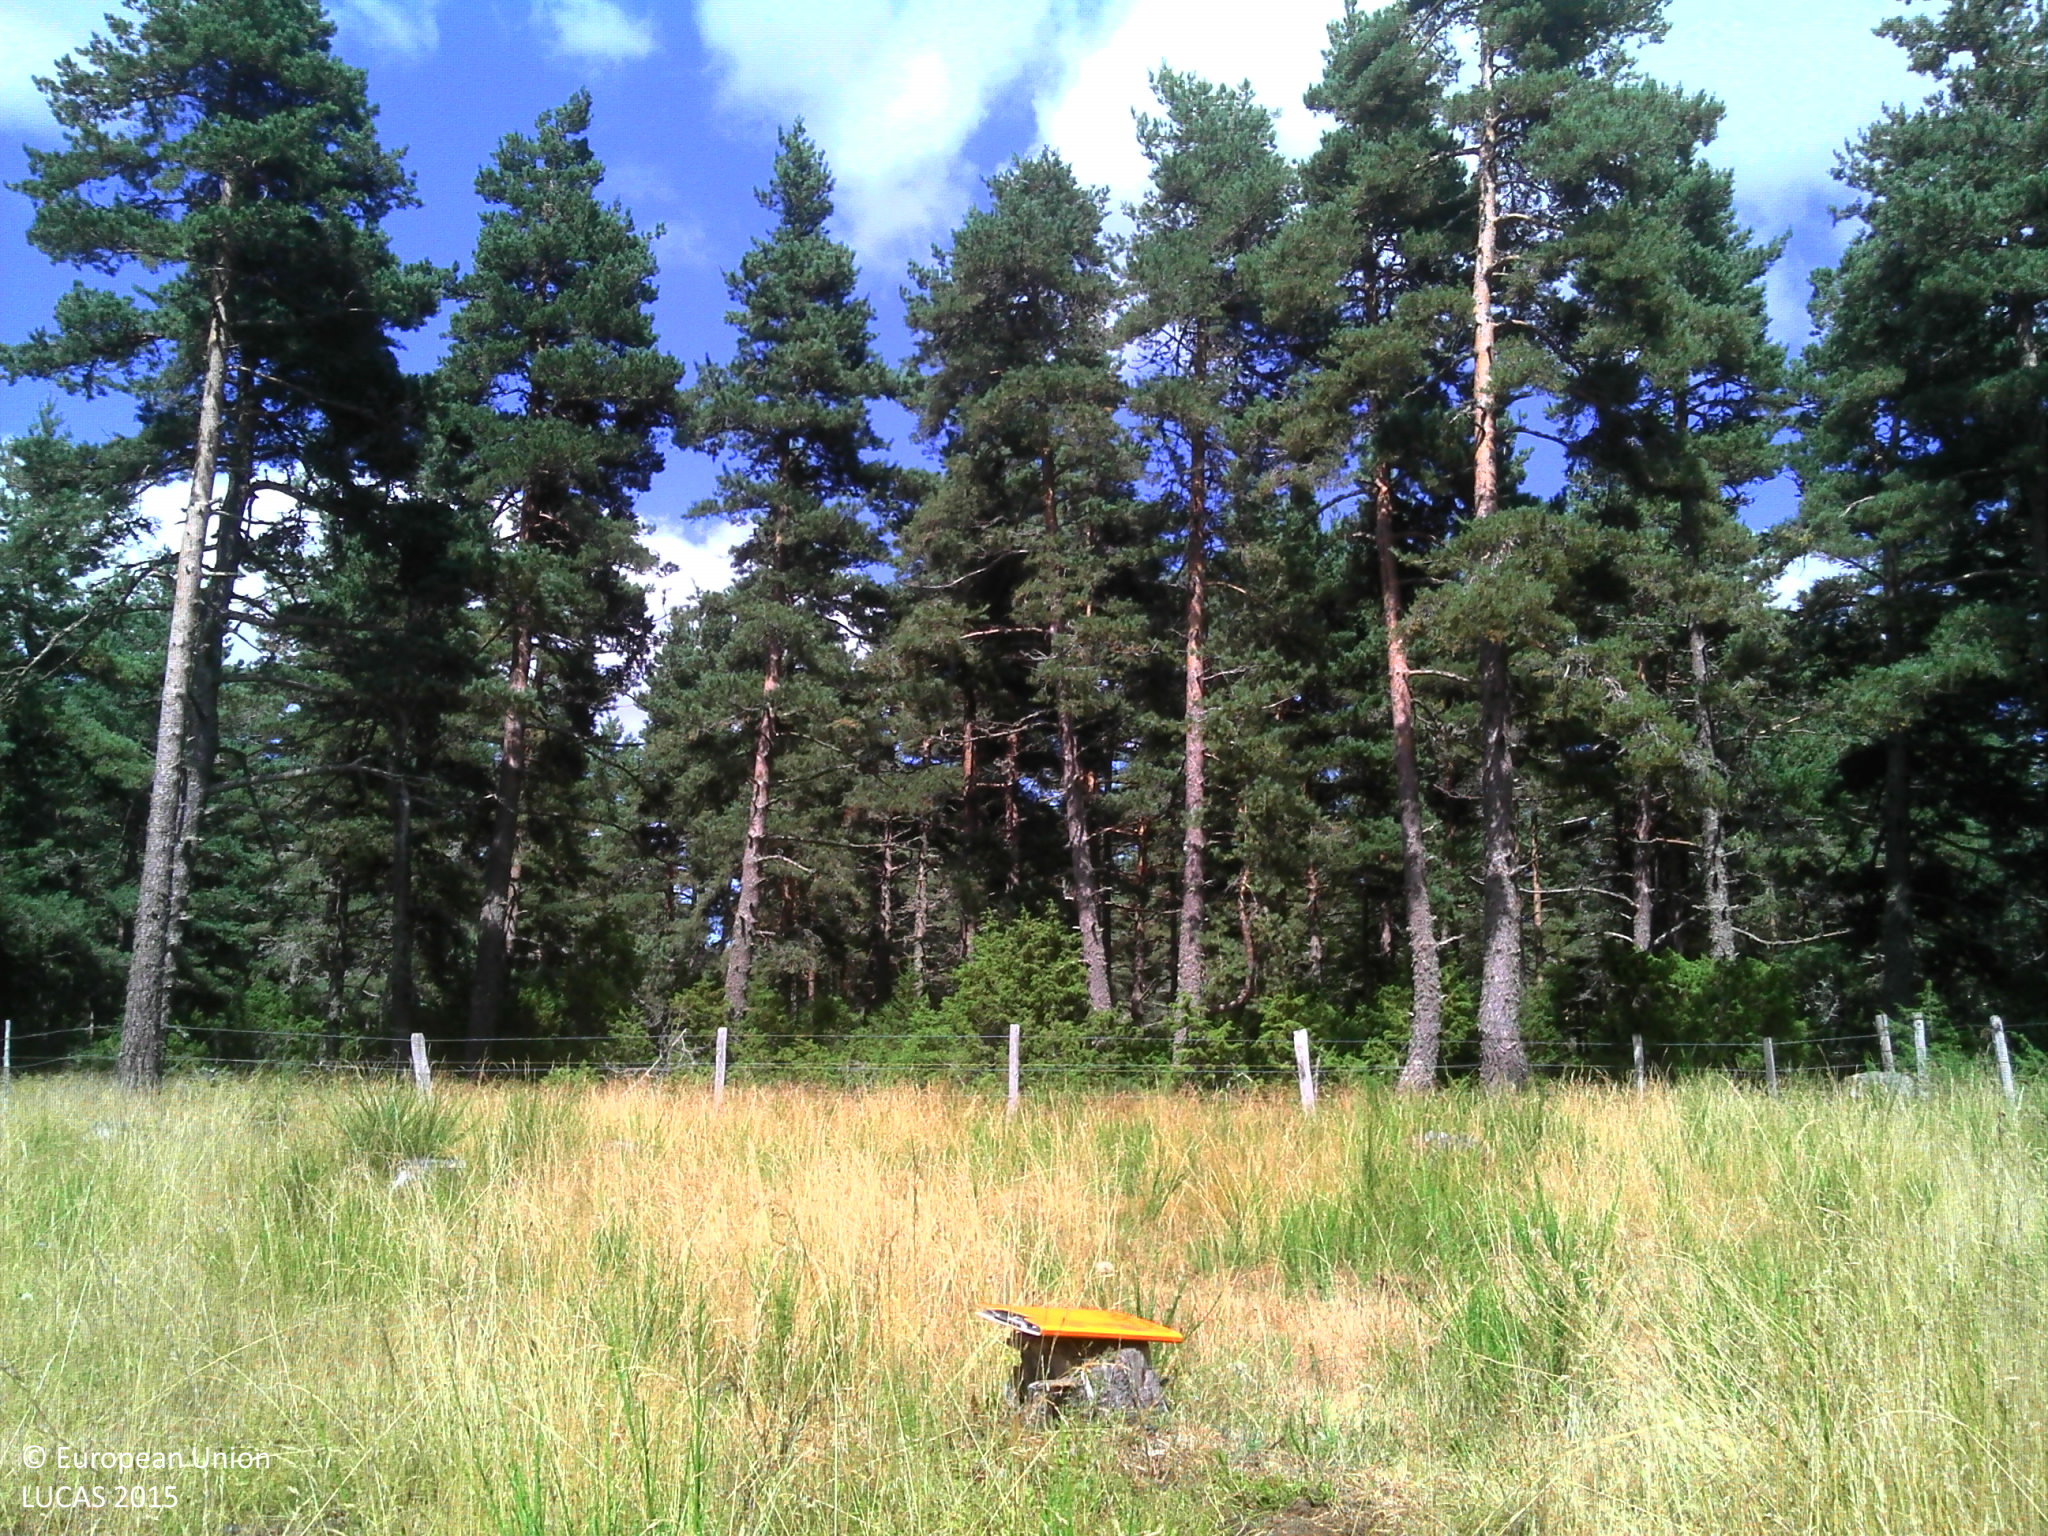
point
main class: Grassland
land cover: Grassland without tree/shrub cover
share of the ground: > 75 %
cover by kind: herbaceous plants 95 %, shrubs 5 %
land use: Agriculture (excluding fallow land and kitchen gardens)
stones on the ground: 10 - 25 %
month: July
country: FR
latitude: 44.7945
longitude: 3.1647
